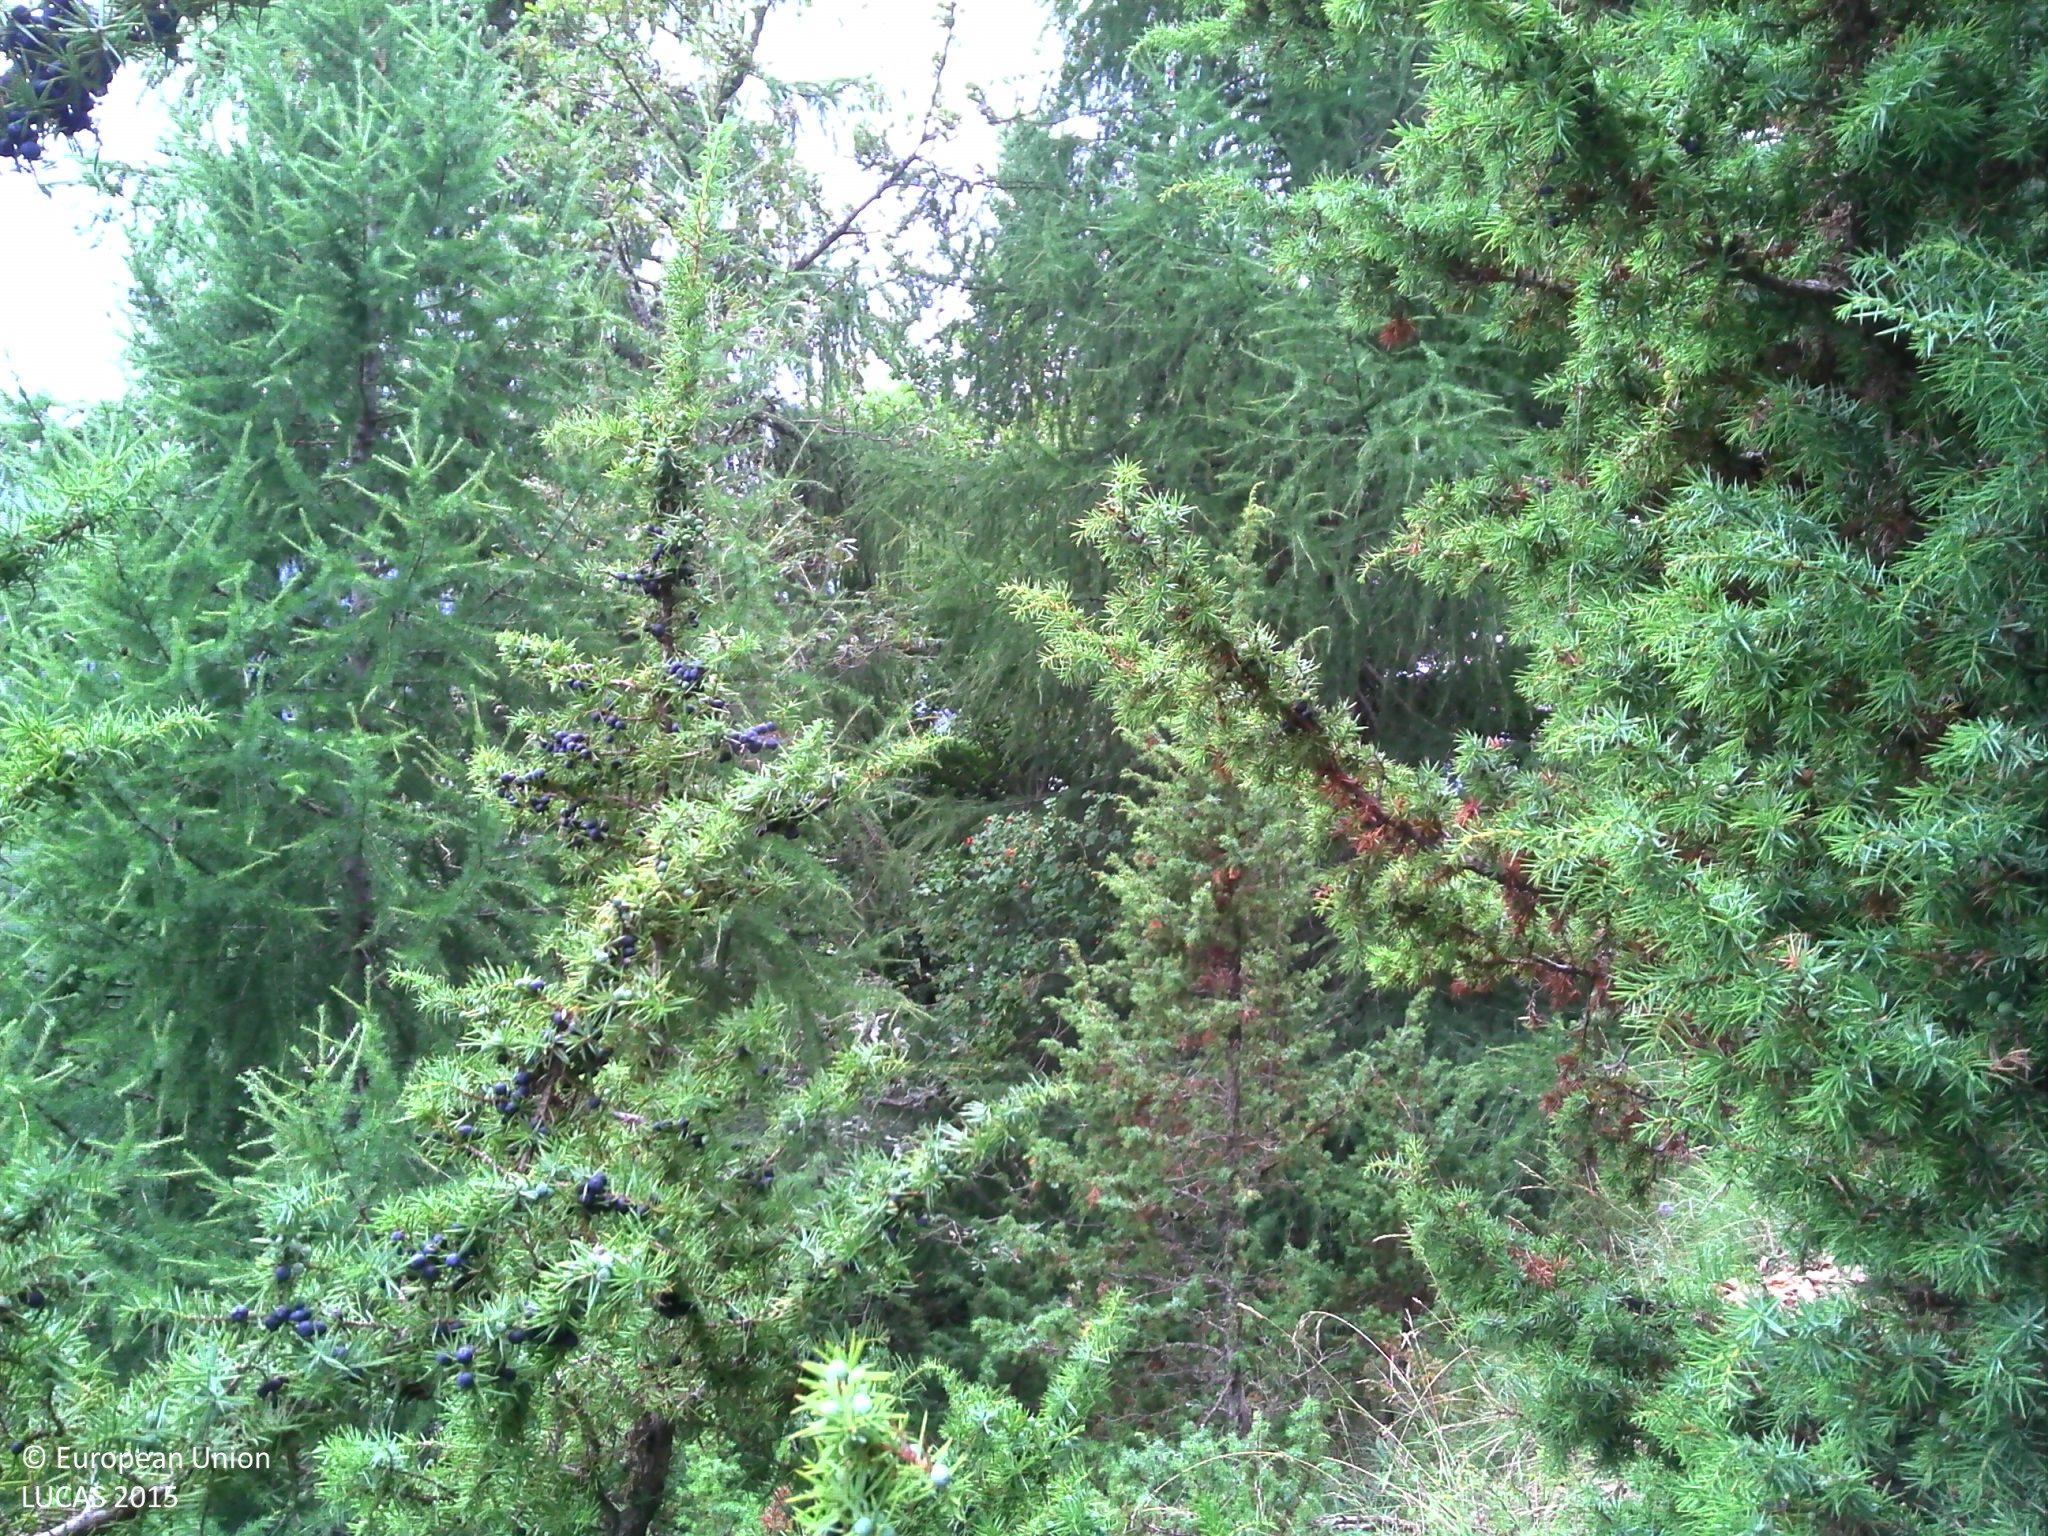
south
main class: Woodland
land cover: Other mixed woodland
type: hemiboreal forest and nemoral coniferous forest and mixed broadleaved-coniferous forest
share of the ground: > 75 %
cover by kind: coniferous forest trees 60 %, broadleaved forest trees 25 %, shrubs 10 %, herbaceous plants 5 %
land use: Forestry
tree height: > 5 m
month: September
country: FR
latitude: 44.6794
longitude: 6.2342
